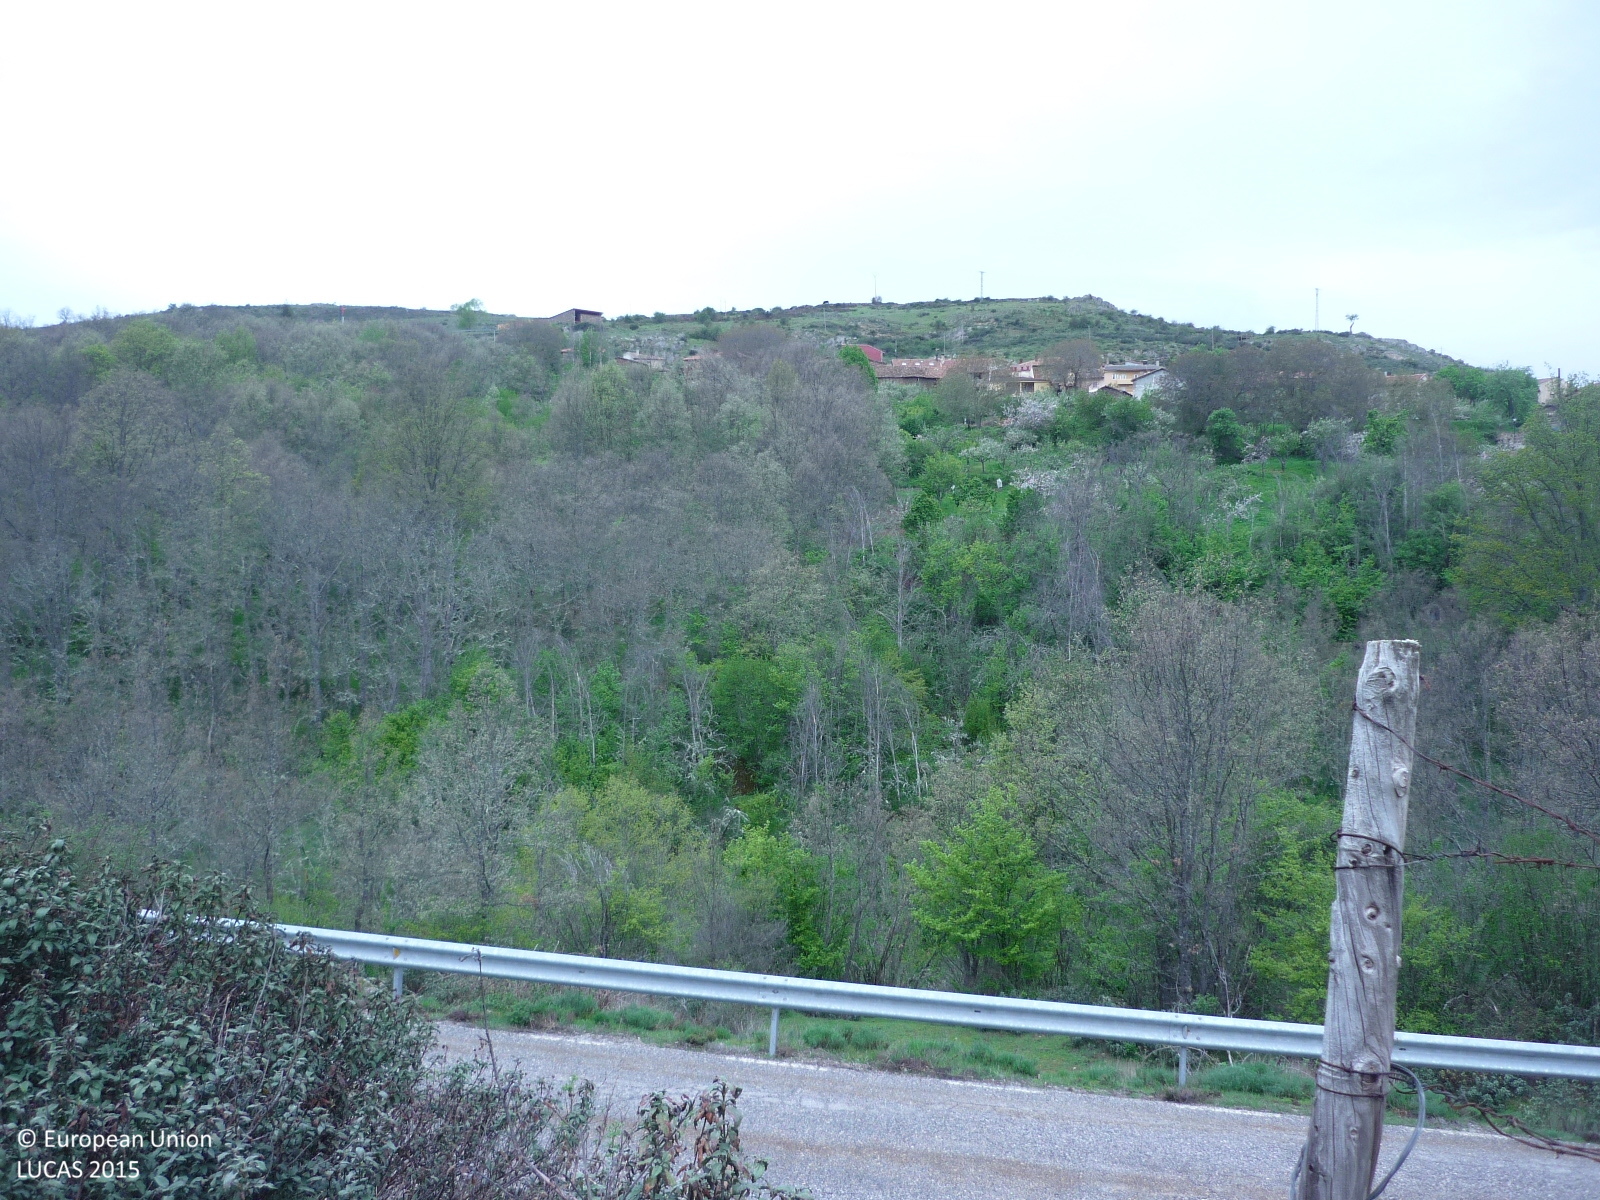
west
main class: Woodland
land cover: Broadleaved woodland
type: thermophilous deciduous forest
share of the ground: > 75 %
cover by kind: broadleaved forest trees 85 %, shrubs 10 %, unconsolidated bare surface 5 %
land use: Semi-natural and natural areas not in use
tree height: > 5 m
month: May
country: ES
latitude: 41.0780
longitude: -3.4325
